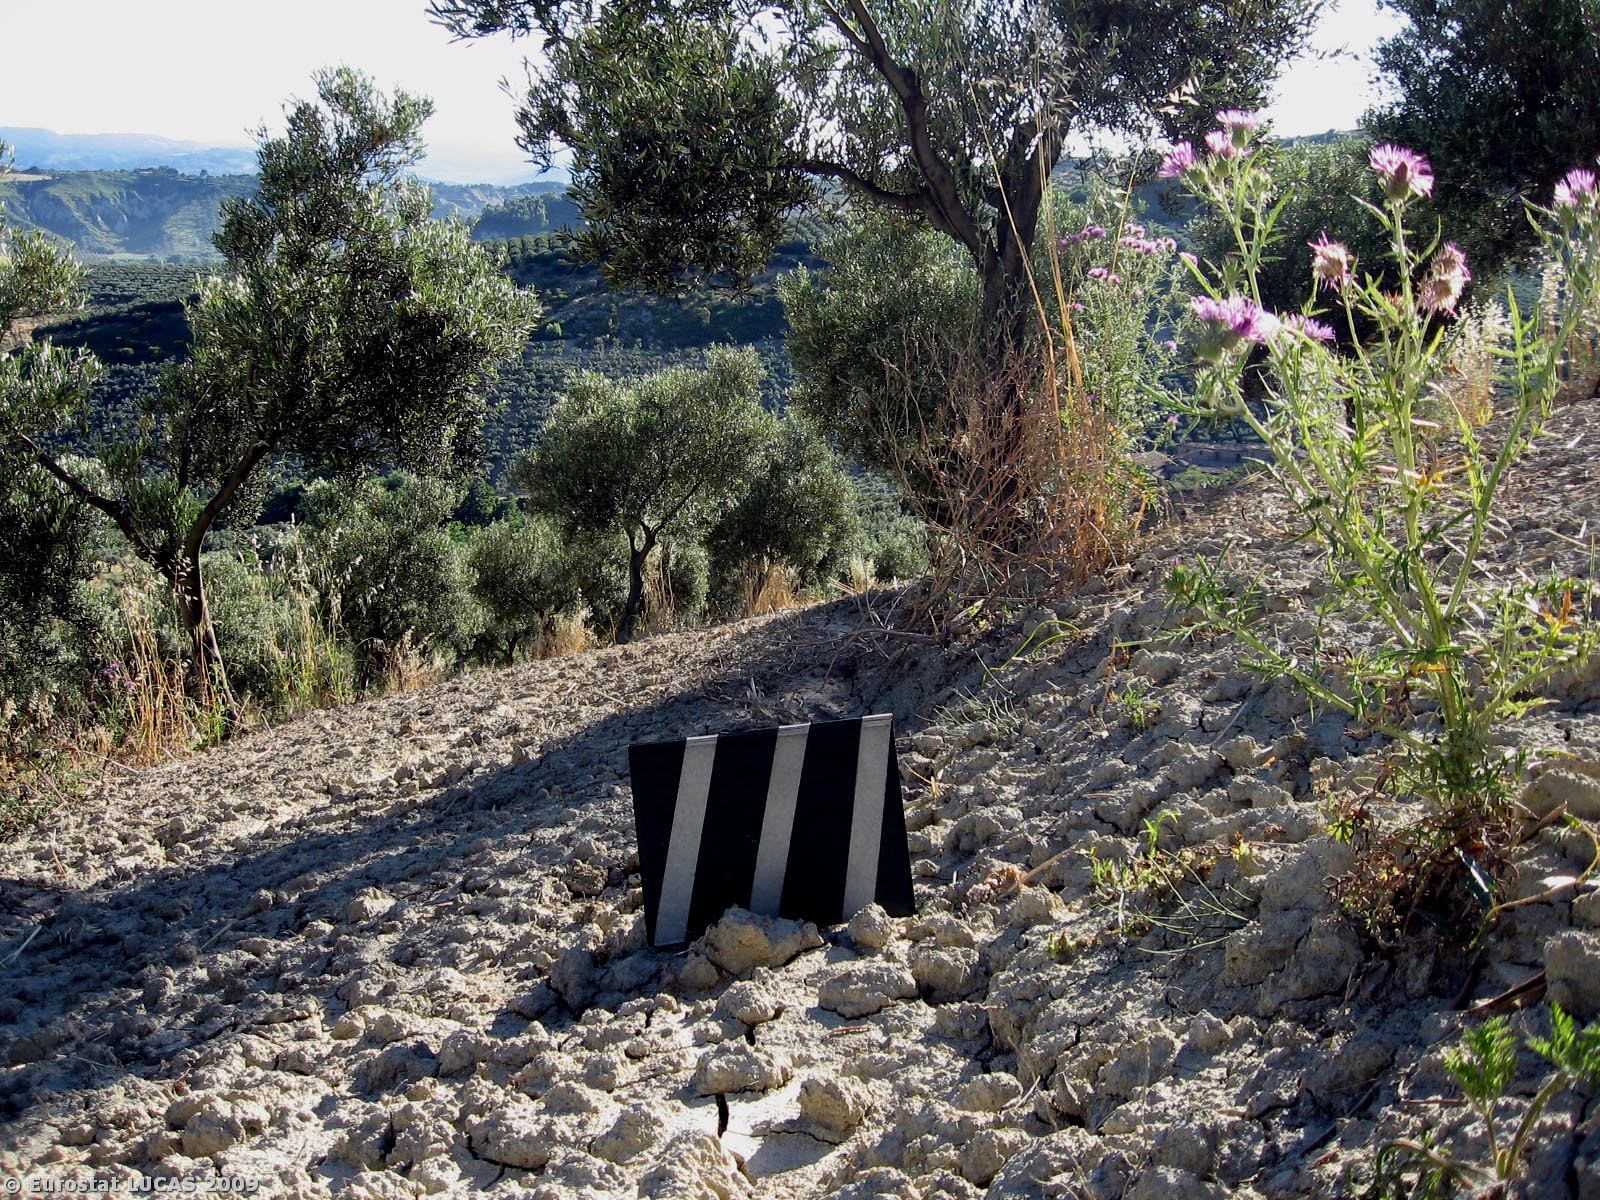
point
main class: Cropland
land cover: Olive groves
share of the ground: 25 - 50 %
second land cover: Bare land
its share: 50 - 75 %
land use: Agriculture (excluding fallow land and kitchen gardens)
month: June
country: IT
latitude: 38.8590
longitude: 16.4080
